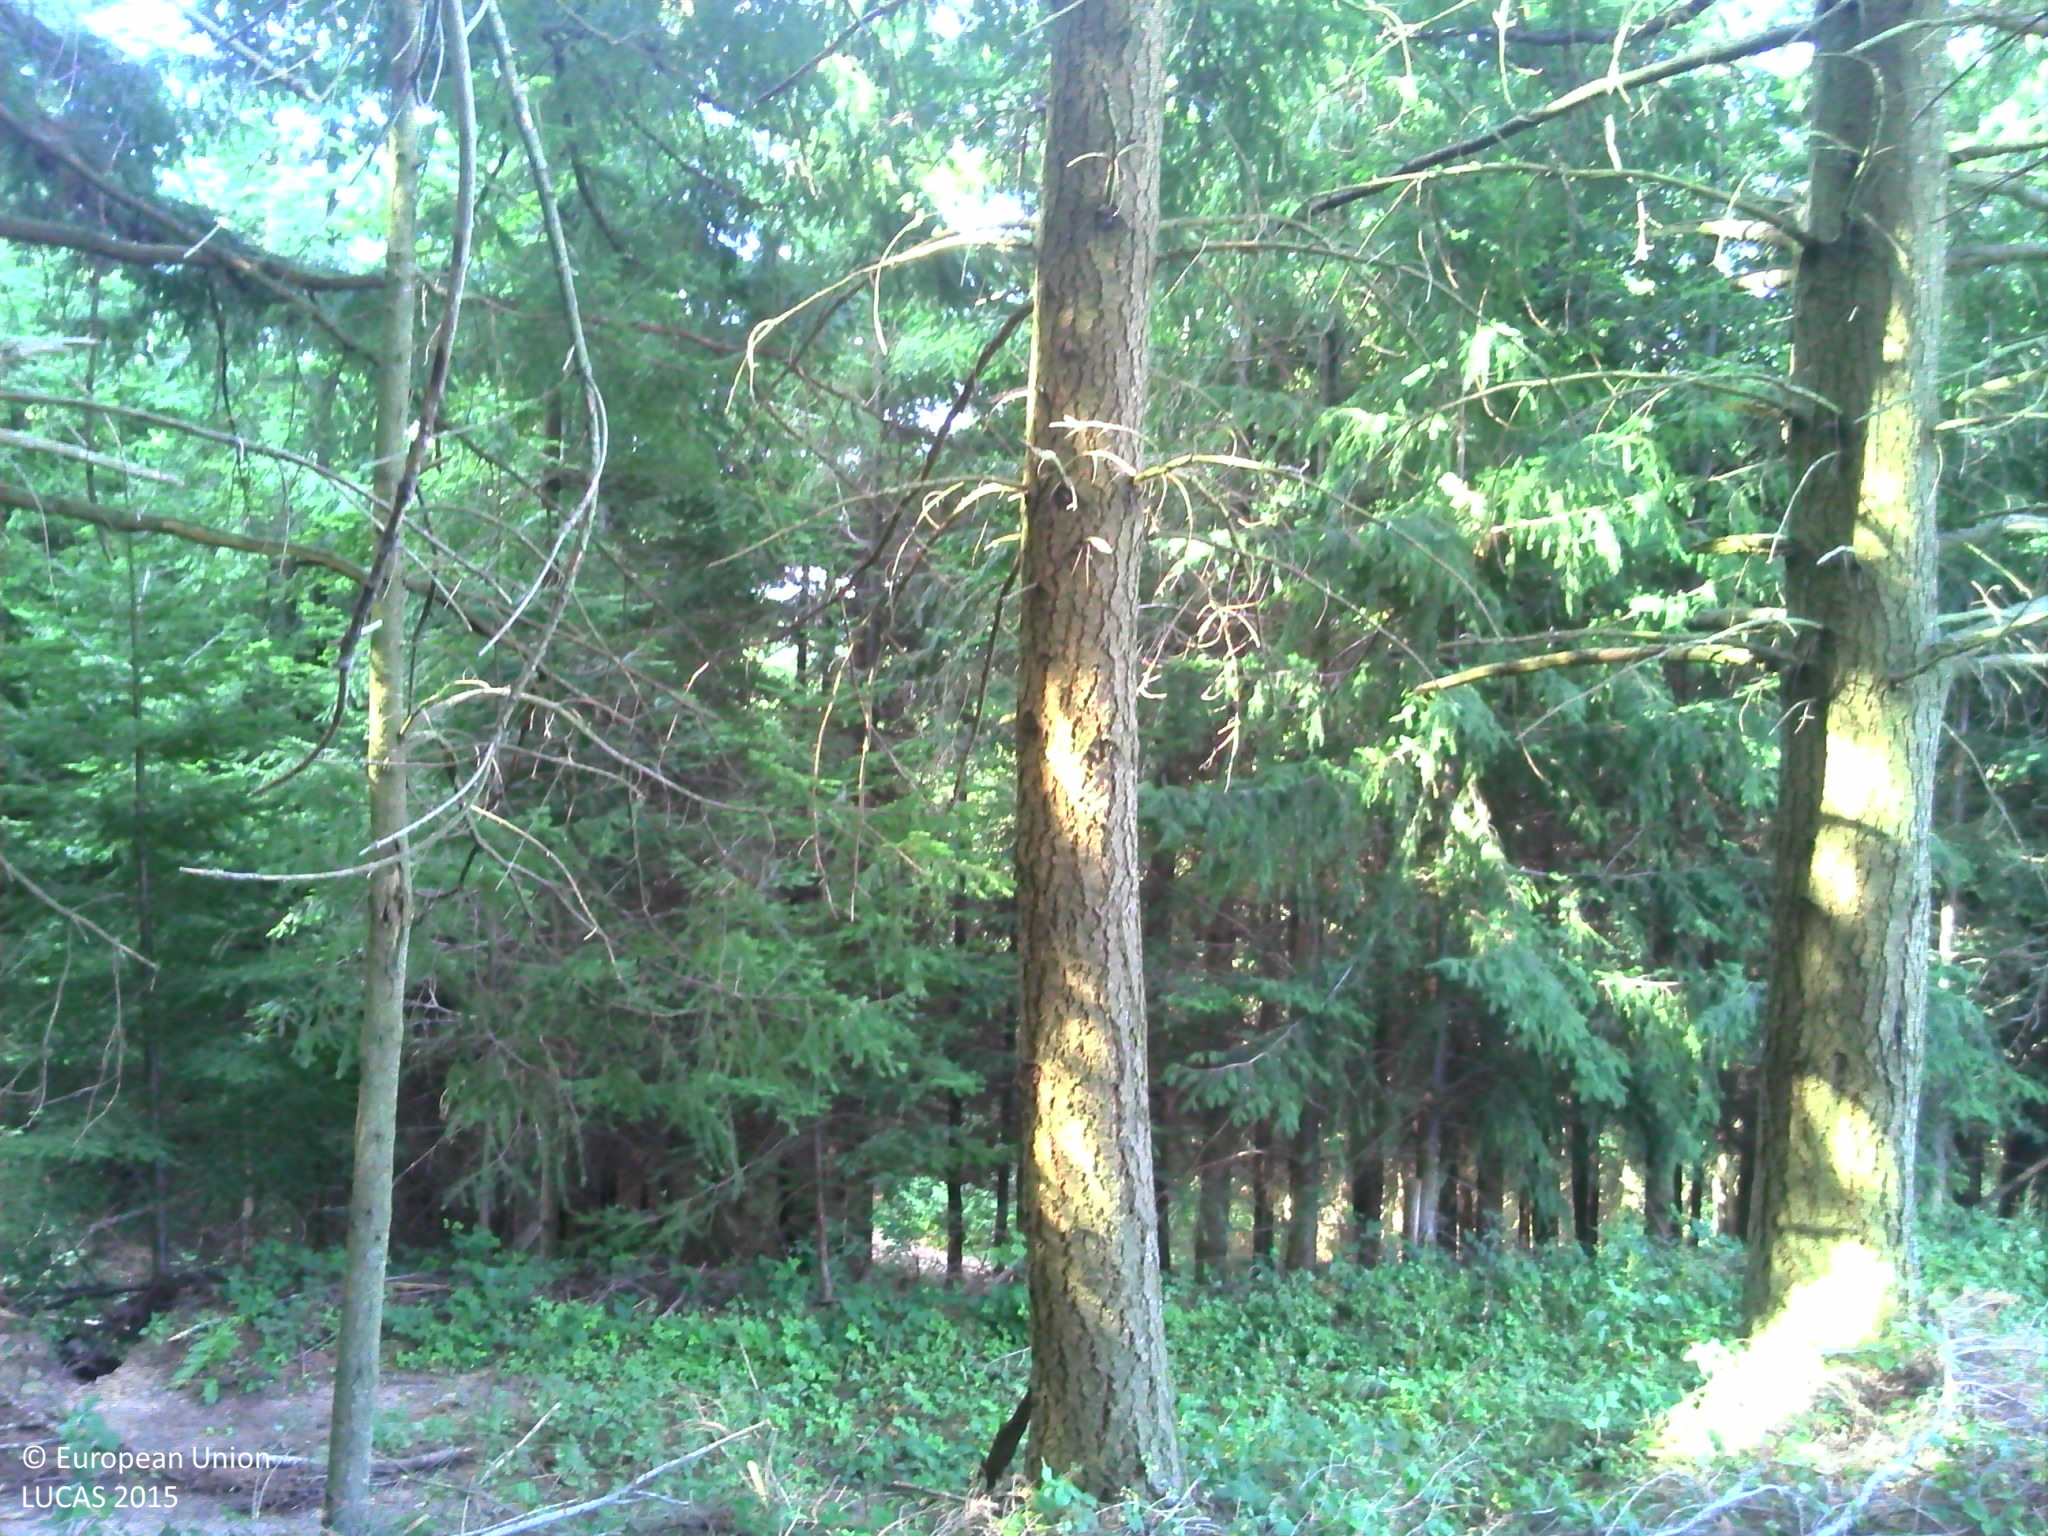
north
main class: Woodland
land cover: Other coniferous woodland
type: alpine coniferous forest
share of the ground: > 75 %
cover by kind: coniferous forest trees 90 %, shrubs 5 %, herbaceous plants 5 %
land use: Forestry
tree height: > 5 m
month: July
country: FR
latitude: 45.0308
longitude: 3.4666
